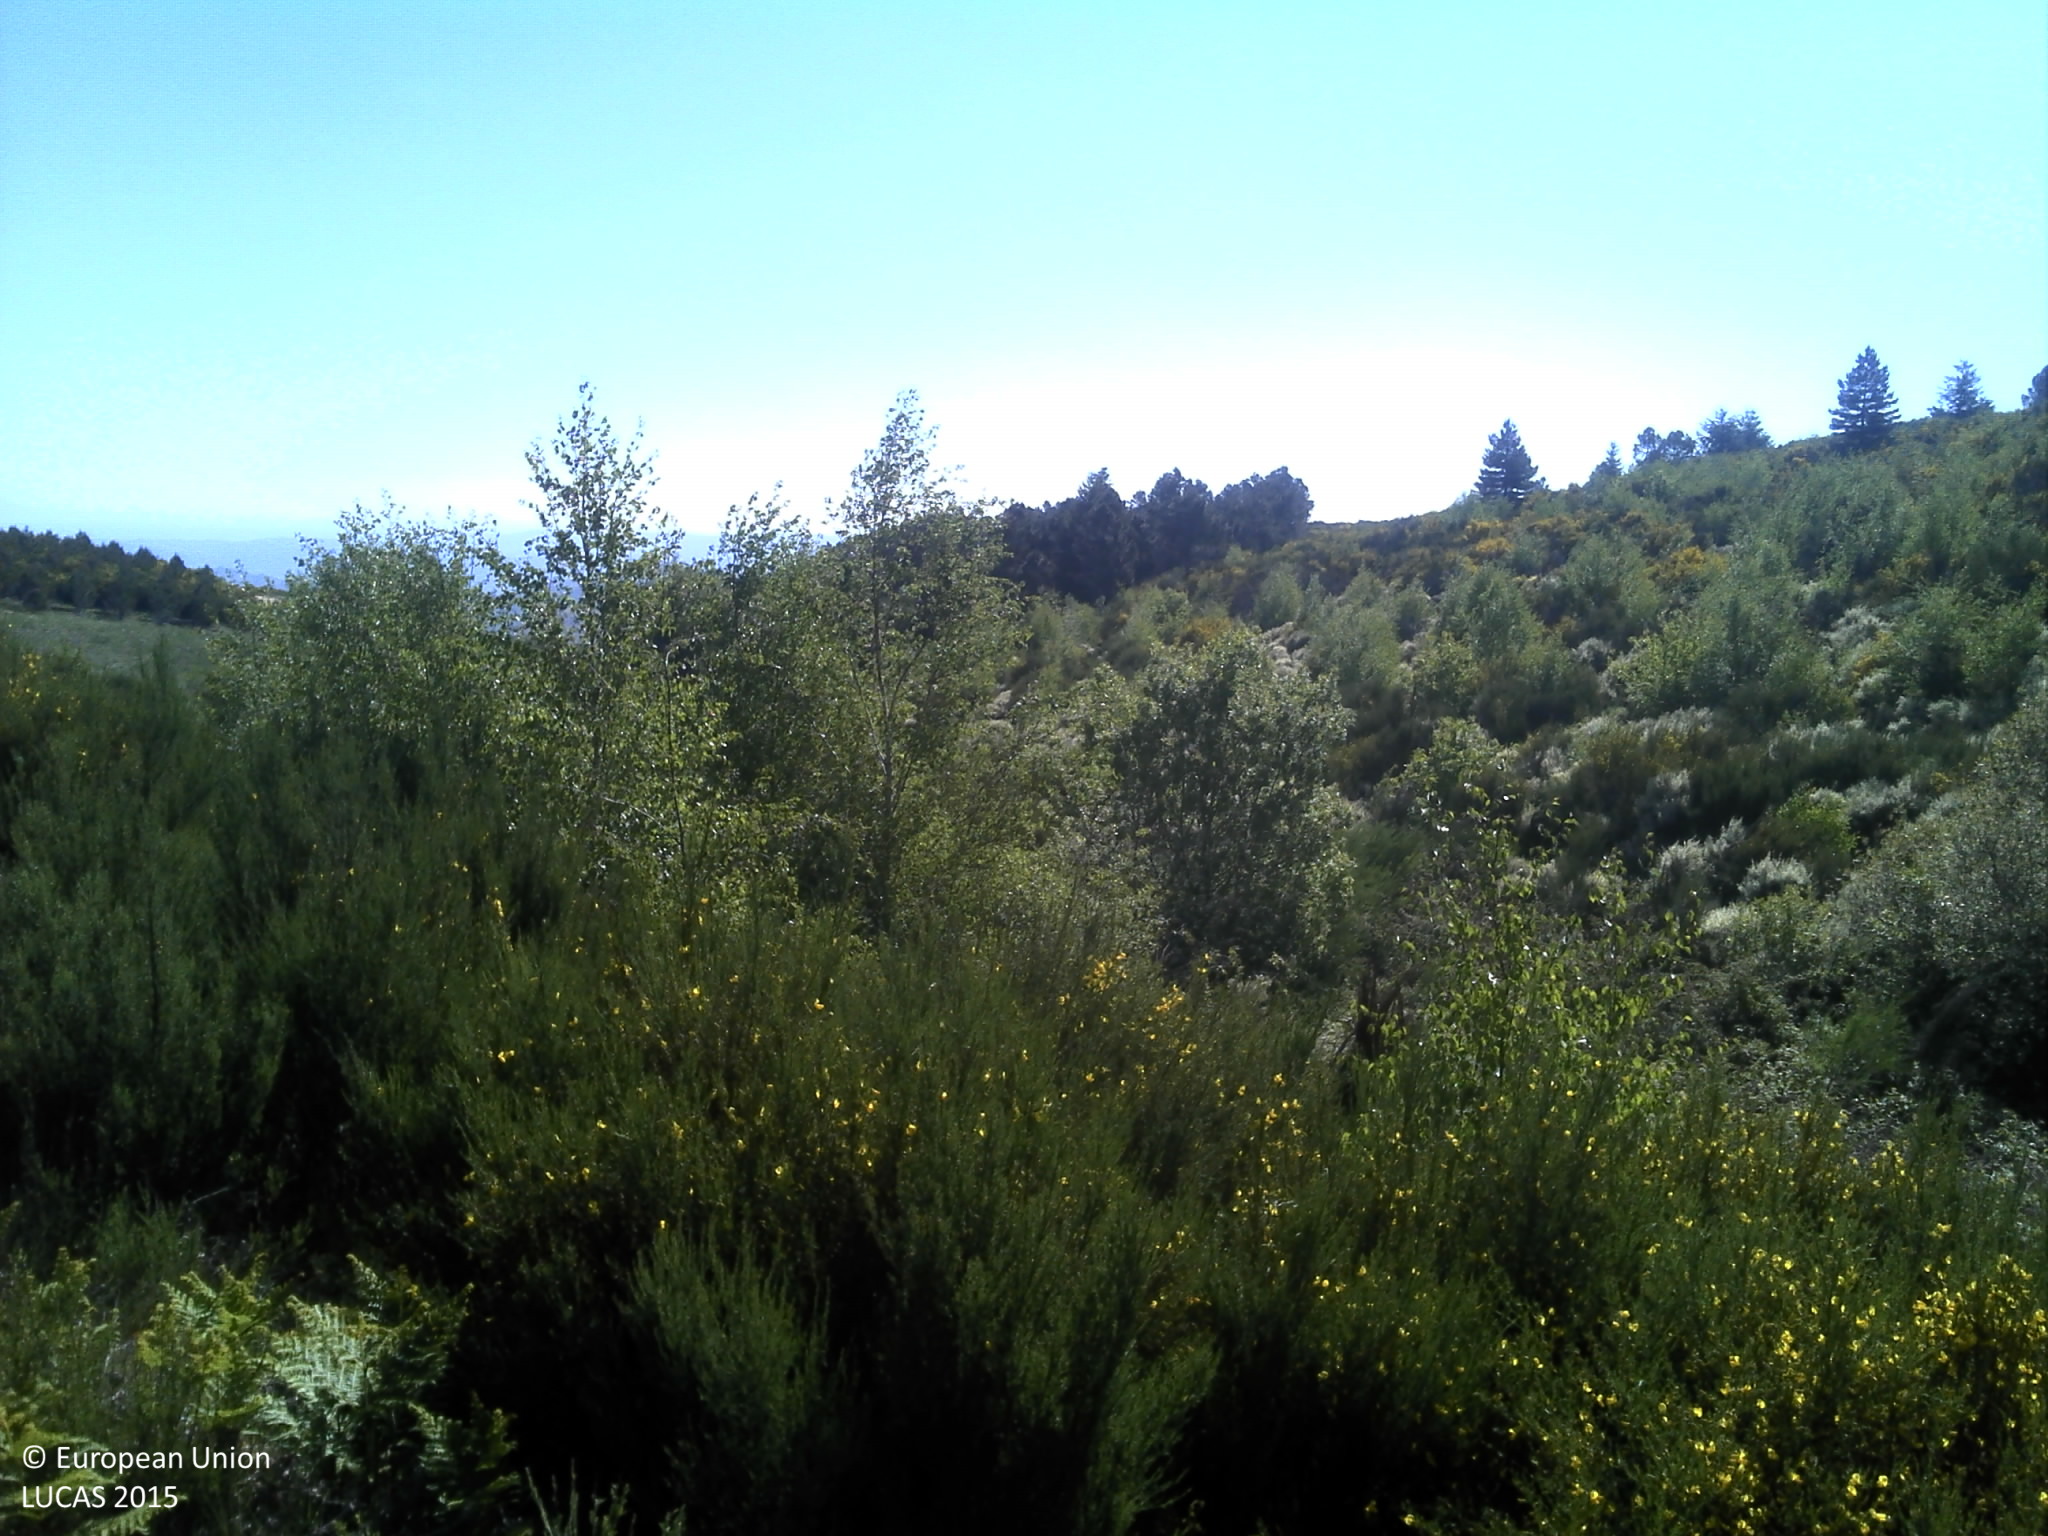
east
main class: Shrubland
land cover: Shrubland without tree cover
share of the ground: > 75 %
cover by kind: shrubs 75 %, herbaceous plants 15 %, unconsolidated bare surface 10 %
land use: Semi-natural and natural areas not in use
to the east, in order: Shrubland without tree cover; Pine dominated coniferous woodland
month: May
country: PT
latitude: 40.5429
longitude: -7.4071
